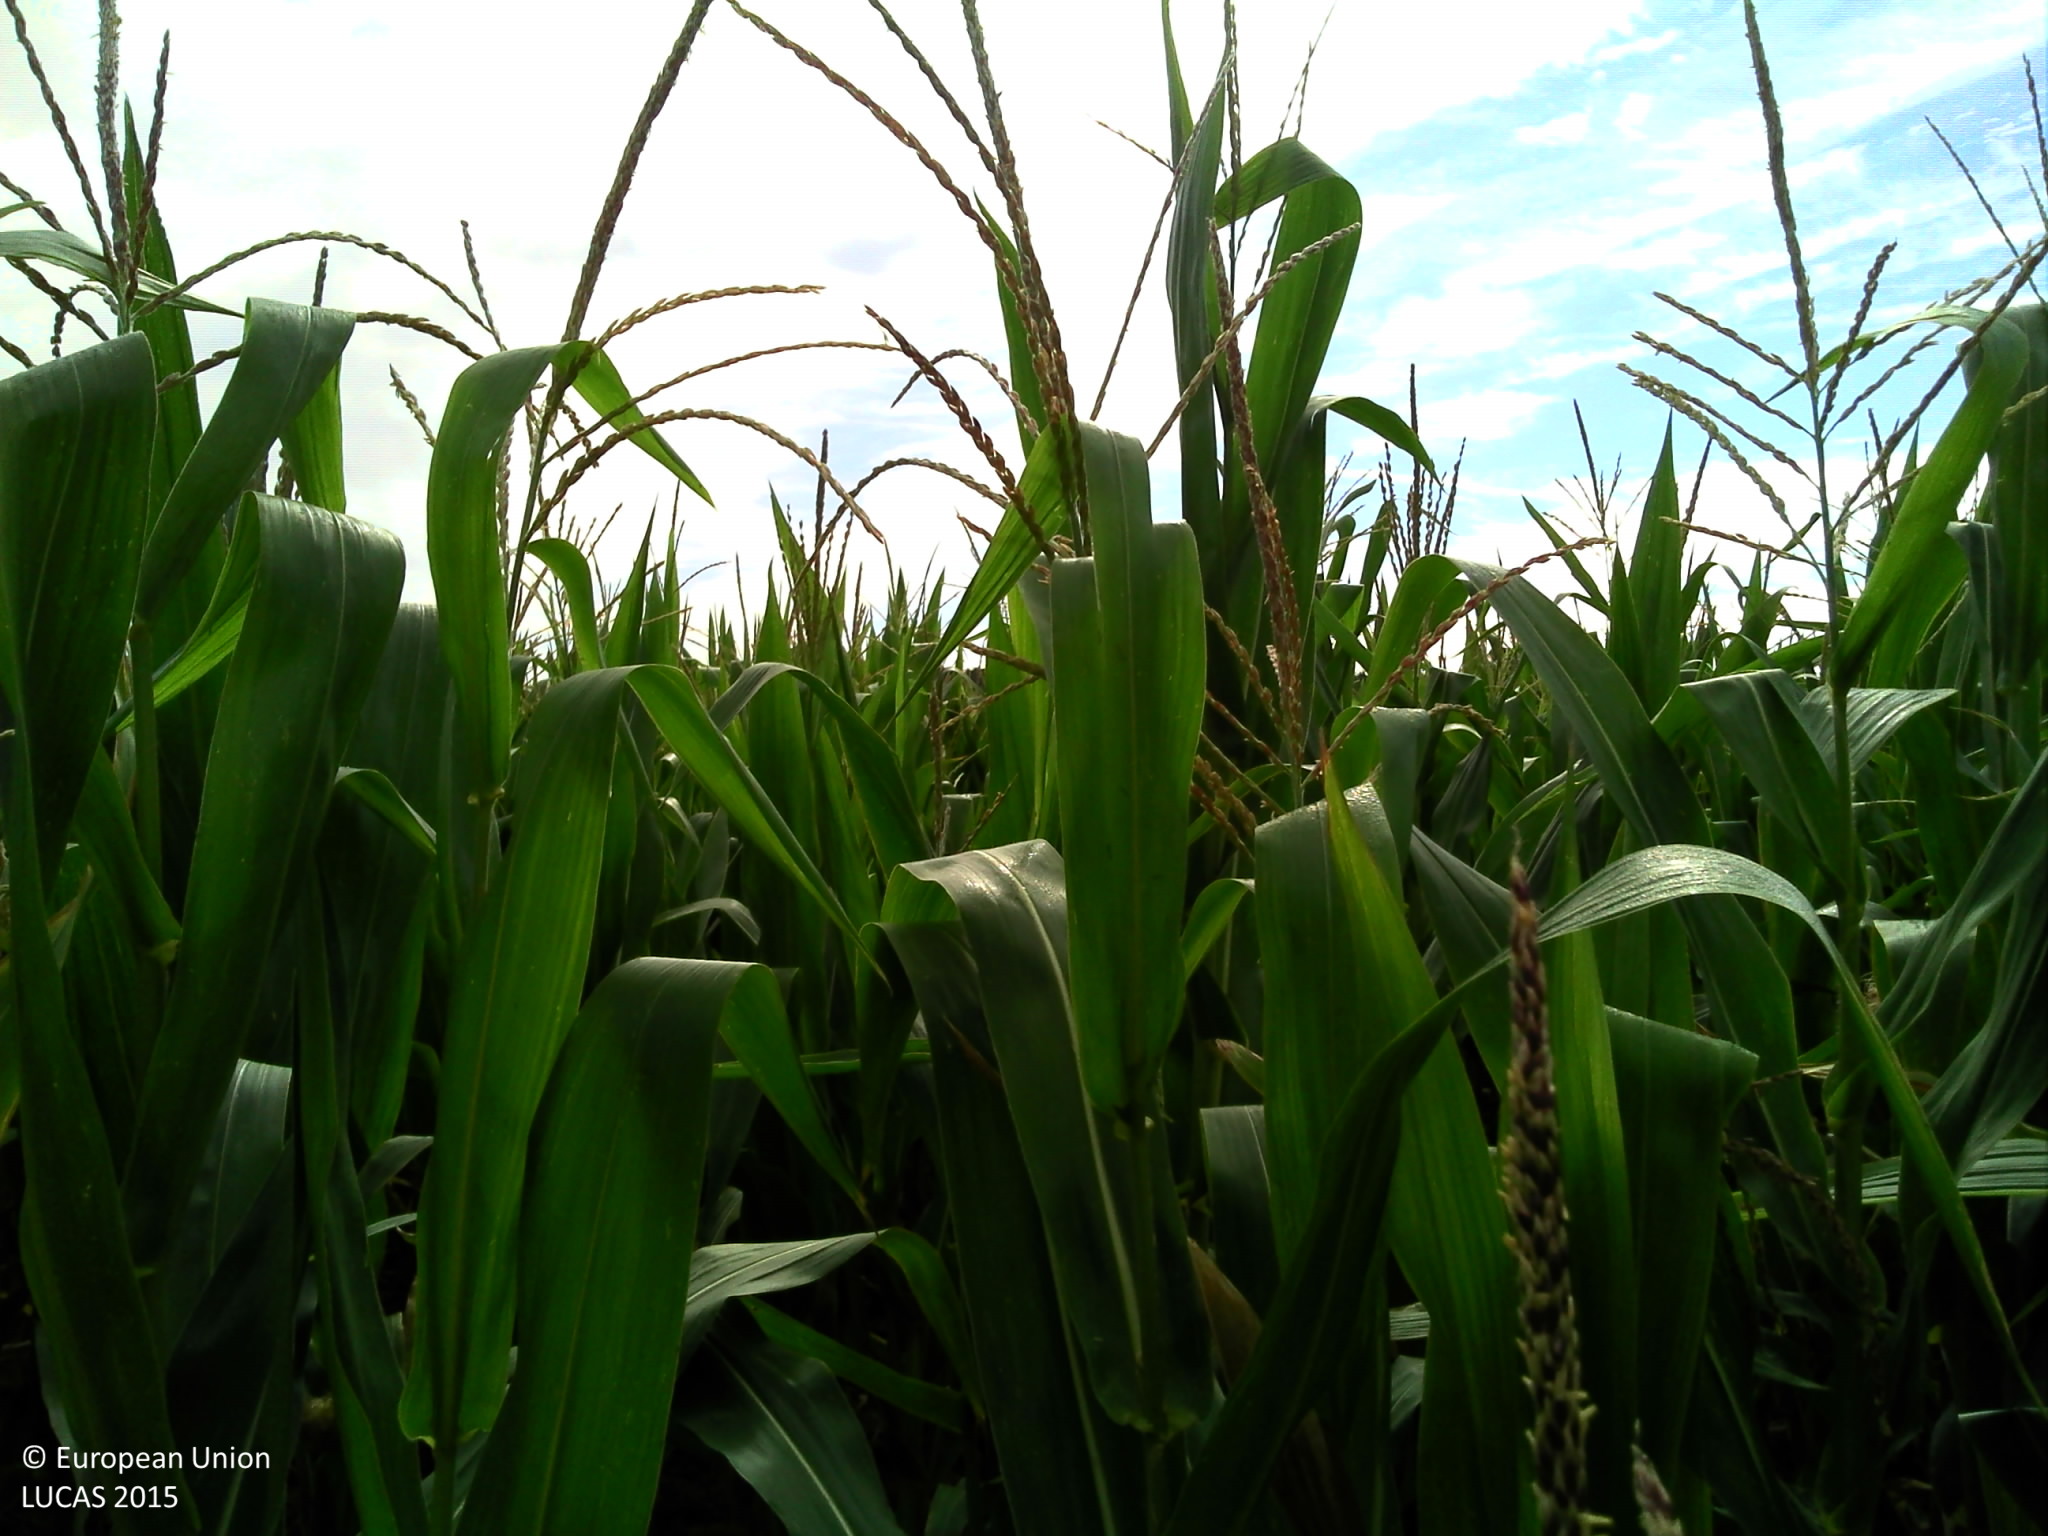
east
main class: Cropland
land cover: Maize
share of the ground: 50 - 75 %
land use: Agriculture (excluding fallow land and kitchen gardens)
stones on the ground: < 10 %
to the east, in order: Maize; Vineyards; Fences; Grassland without tree/shrub cover; Fences; Ditches and canals; Grass margins; Paved roads, cycling and walking lanes; Grass margins; Fences; Grassland without tree/shrub cover; Grassland with sparse tree/shrub cover
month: July
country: FR
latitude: 45.0054
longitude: 1.1509
